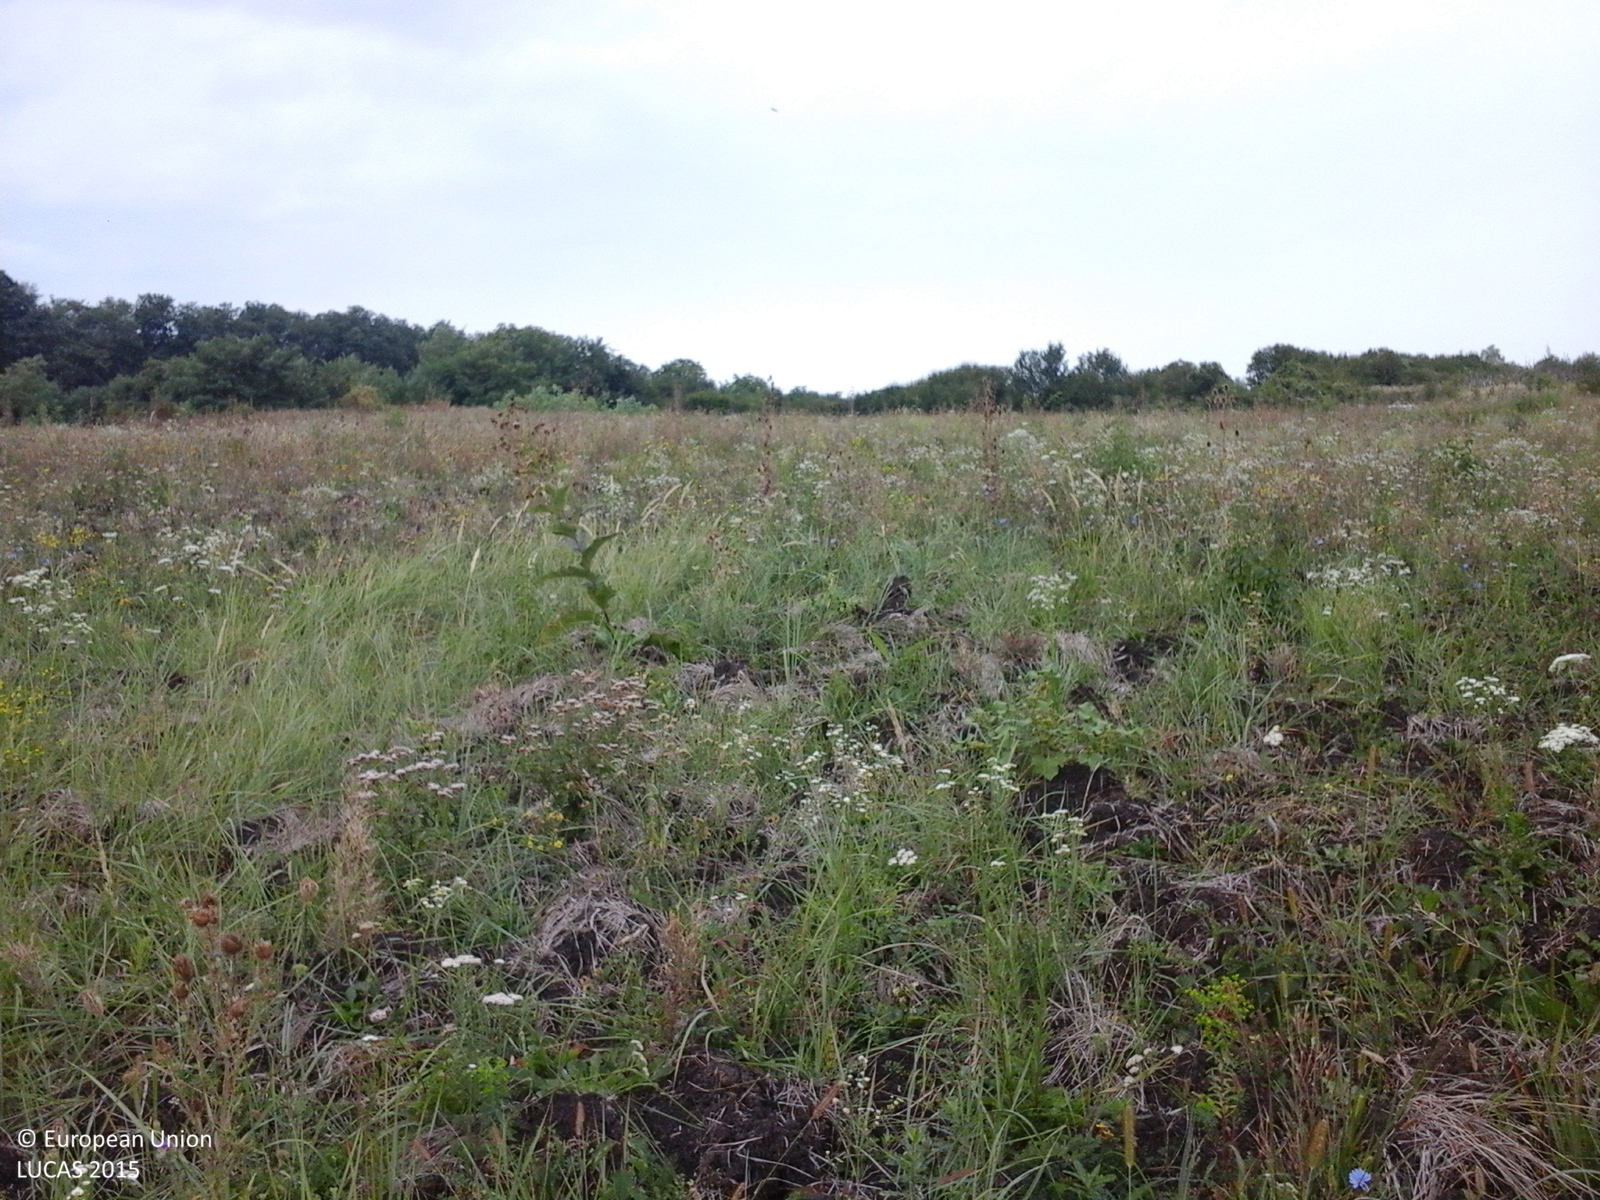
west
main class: Grassland
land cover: Spontaneously vegetated surfaces
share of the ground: > 75 %
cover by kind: herbaceous plants 100 %
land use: Fallow land
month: September
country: RO
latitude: 47.2577
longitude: 23.0815
